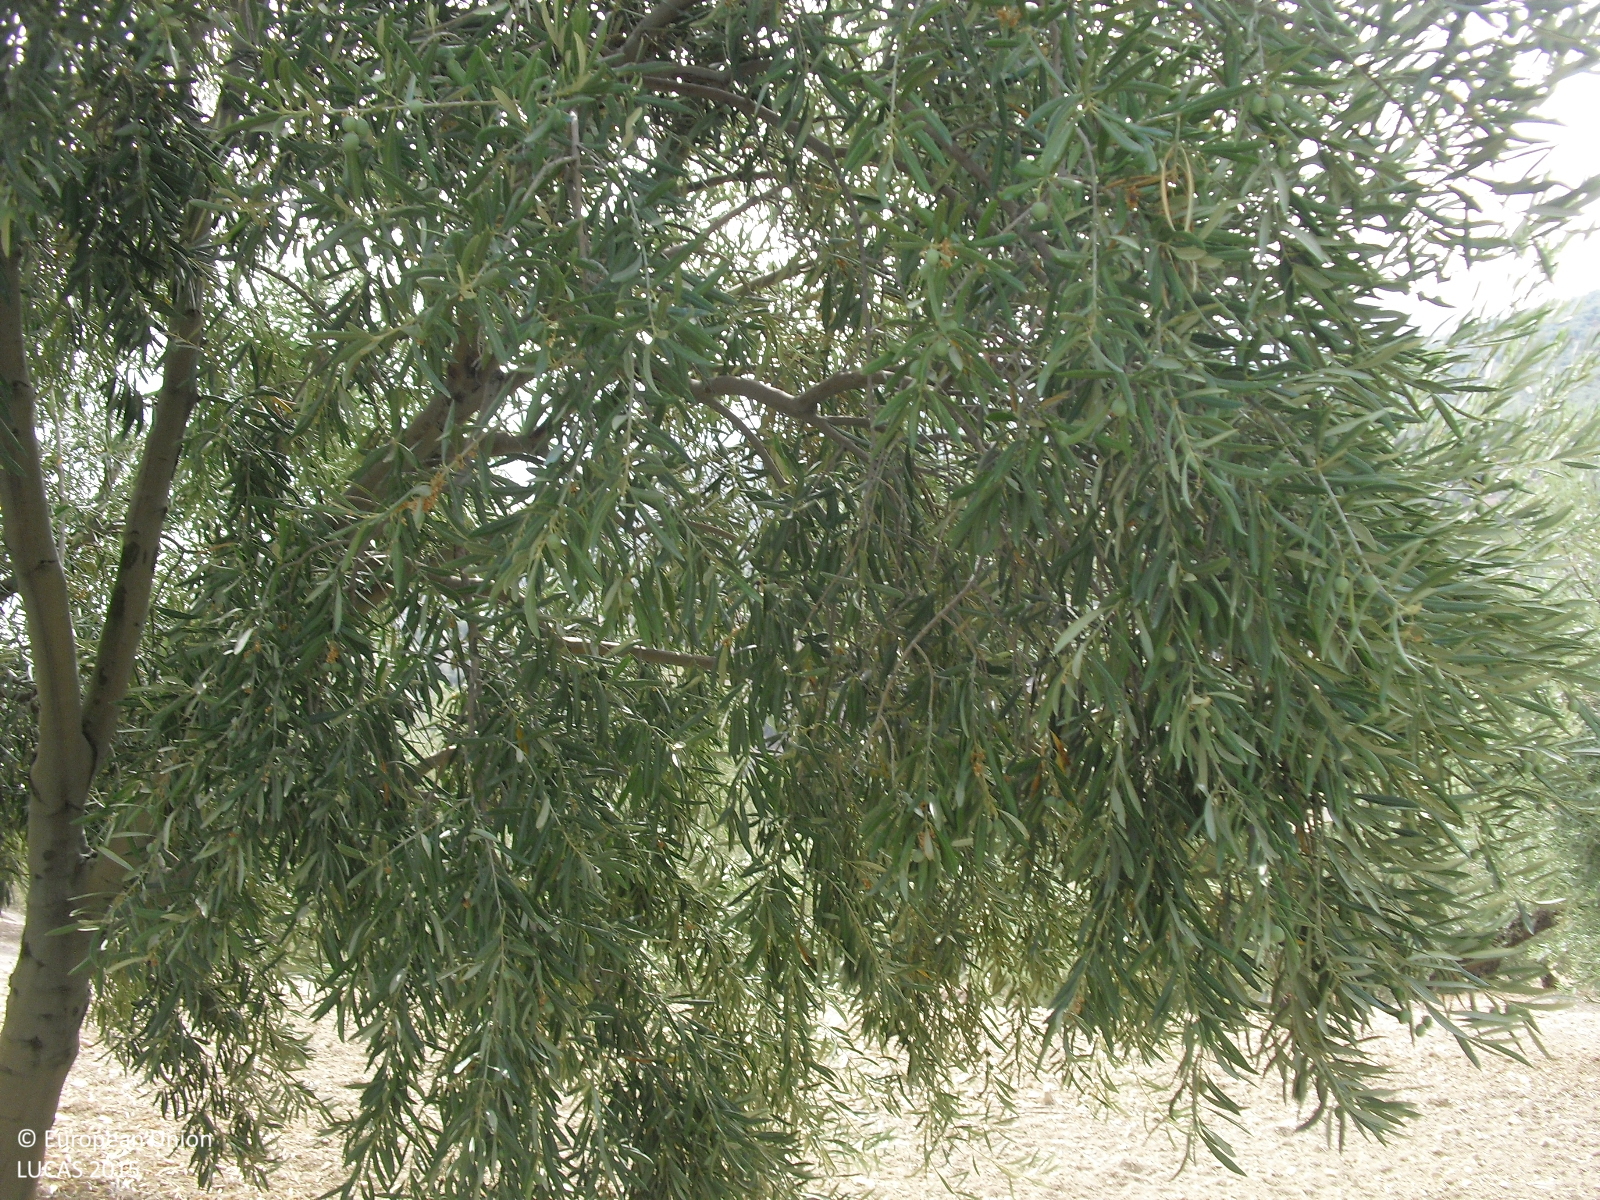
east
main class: Cropland
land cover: Olive groves
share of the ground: 25 - 50 %
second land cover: Other bare soil
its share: > 75 %
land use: Agriculture (excluding fallow land and kitchen gardens)
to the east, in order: Olive groves; Other bare soil; Broadleaved woodland
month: August
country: ES
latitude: 37.2450
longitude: -4.3263
